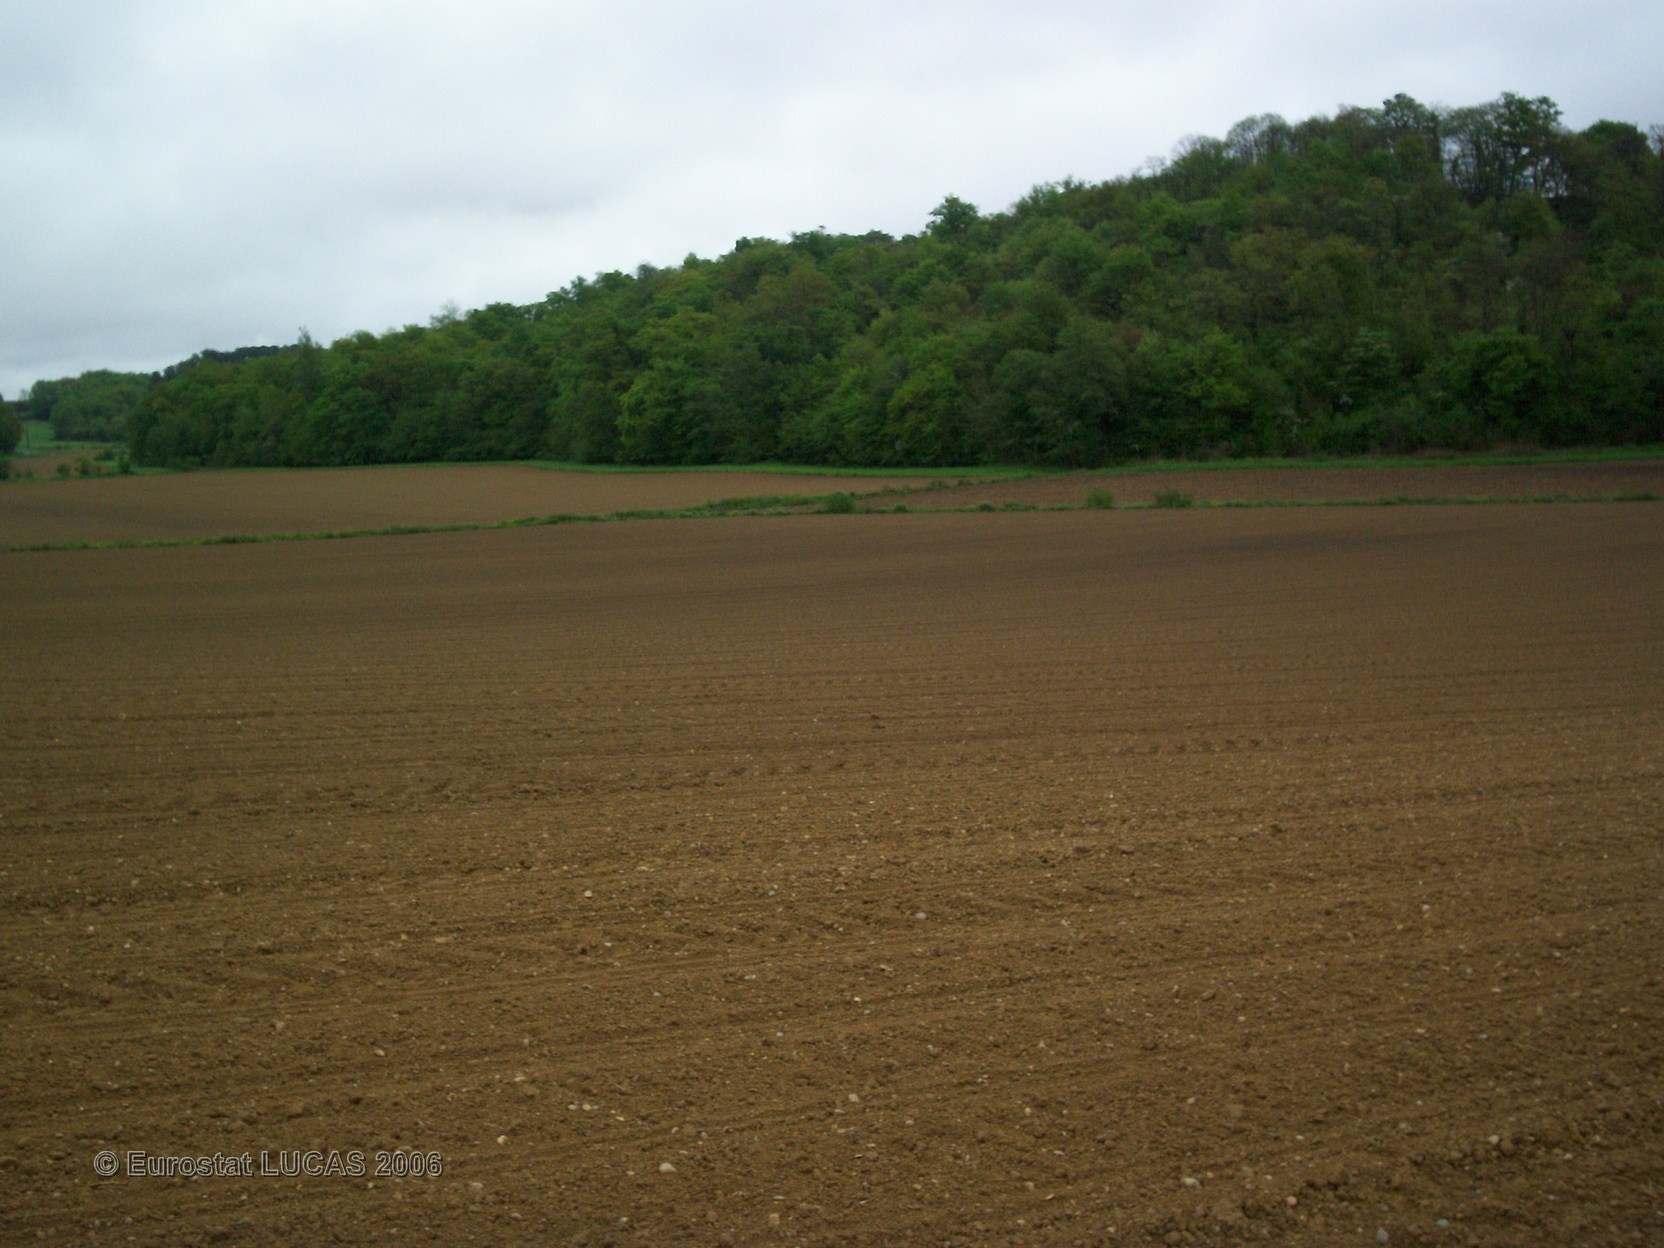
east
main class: Cropland
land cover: Maize
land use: Agriculture (excluding fallow land and kitchen gardens)
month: April
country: FR
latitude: 43.6488
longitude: -0.3614
